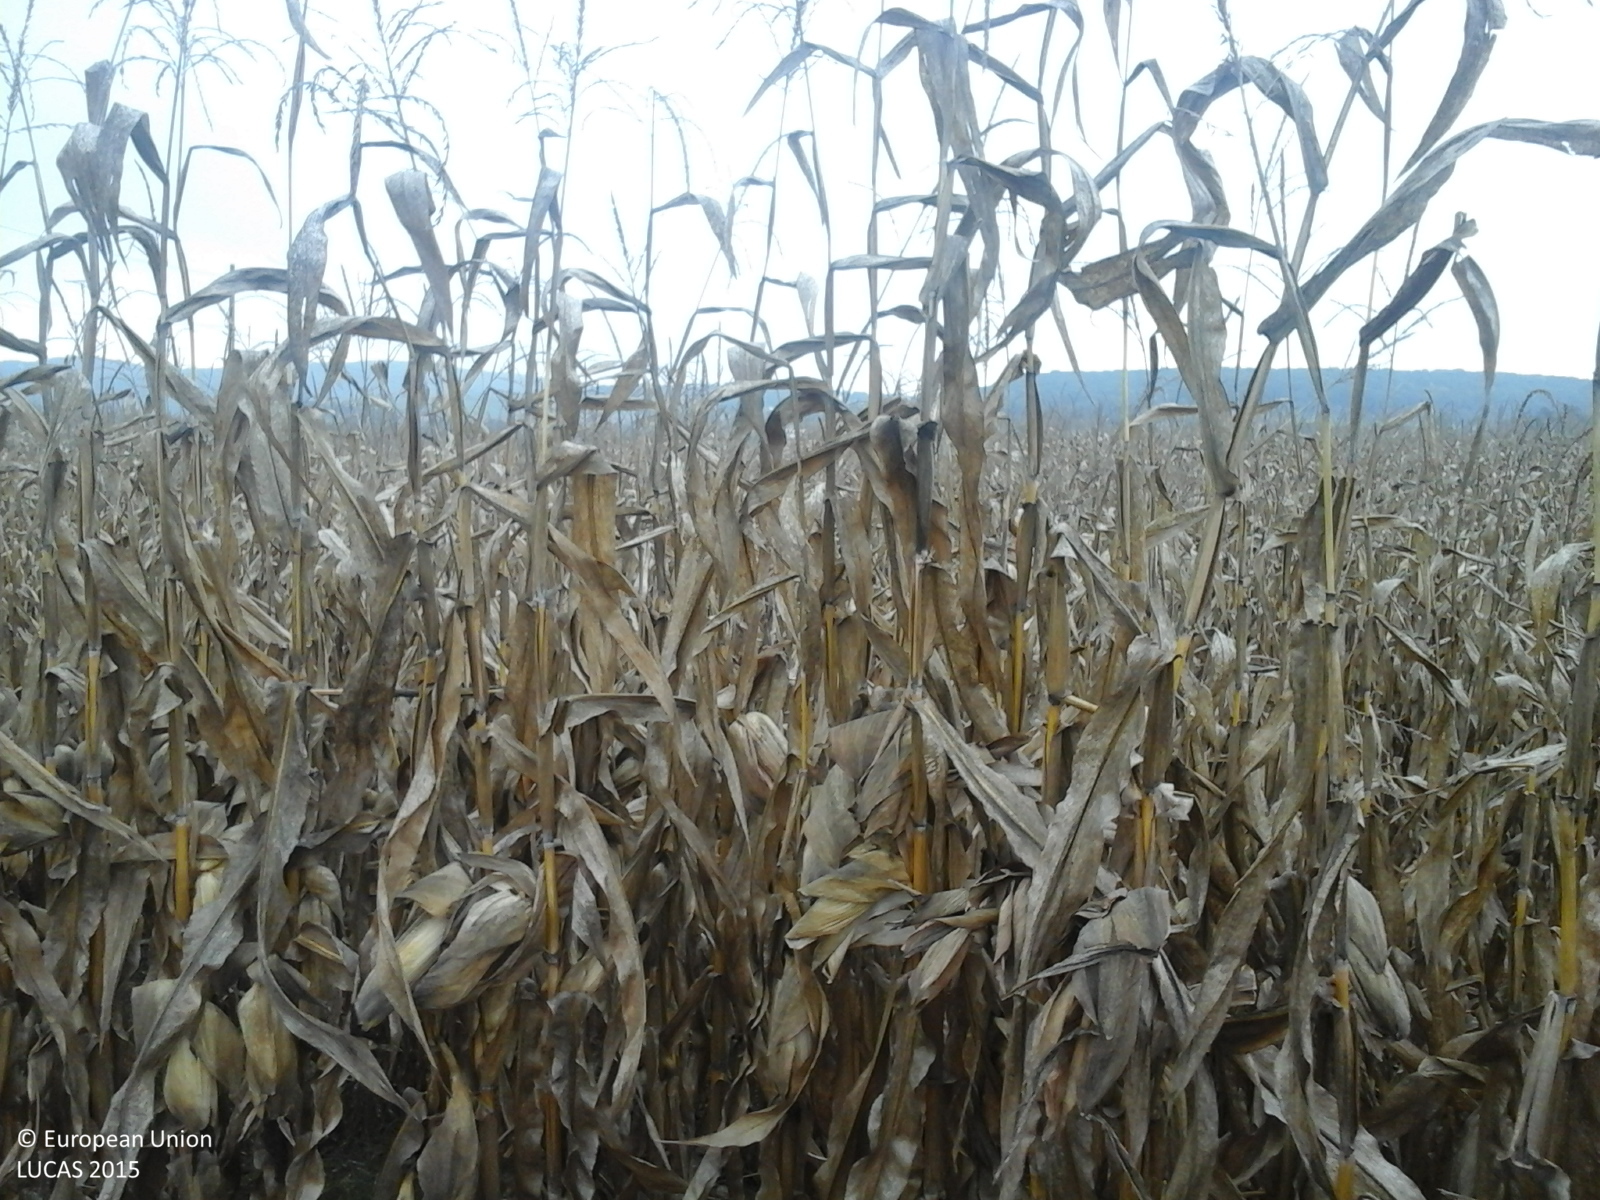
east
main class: Cropland
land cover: Maize
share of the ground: > 75 %
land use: Agriculture (excluding fallow land and kitchen gardens)
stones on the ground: < 10 %
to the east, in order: Maize
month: October
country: RO
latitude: 46.2216
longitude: 24.7262
